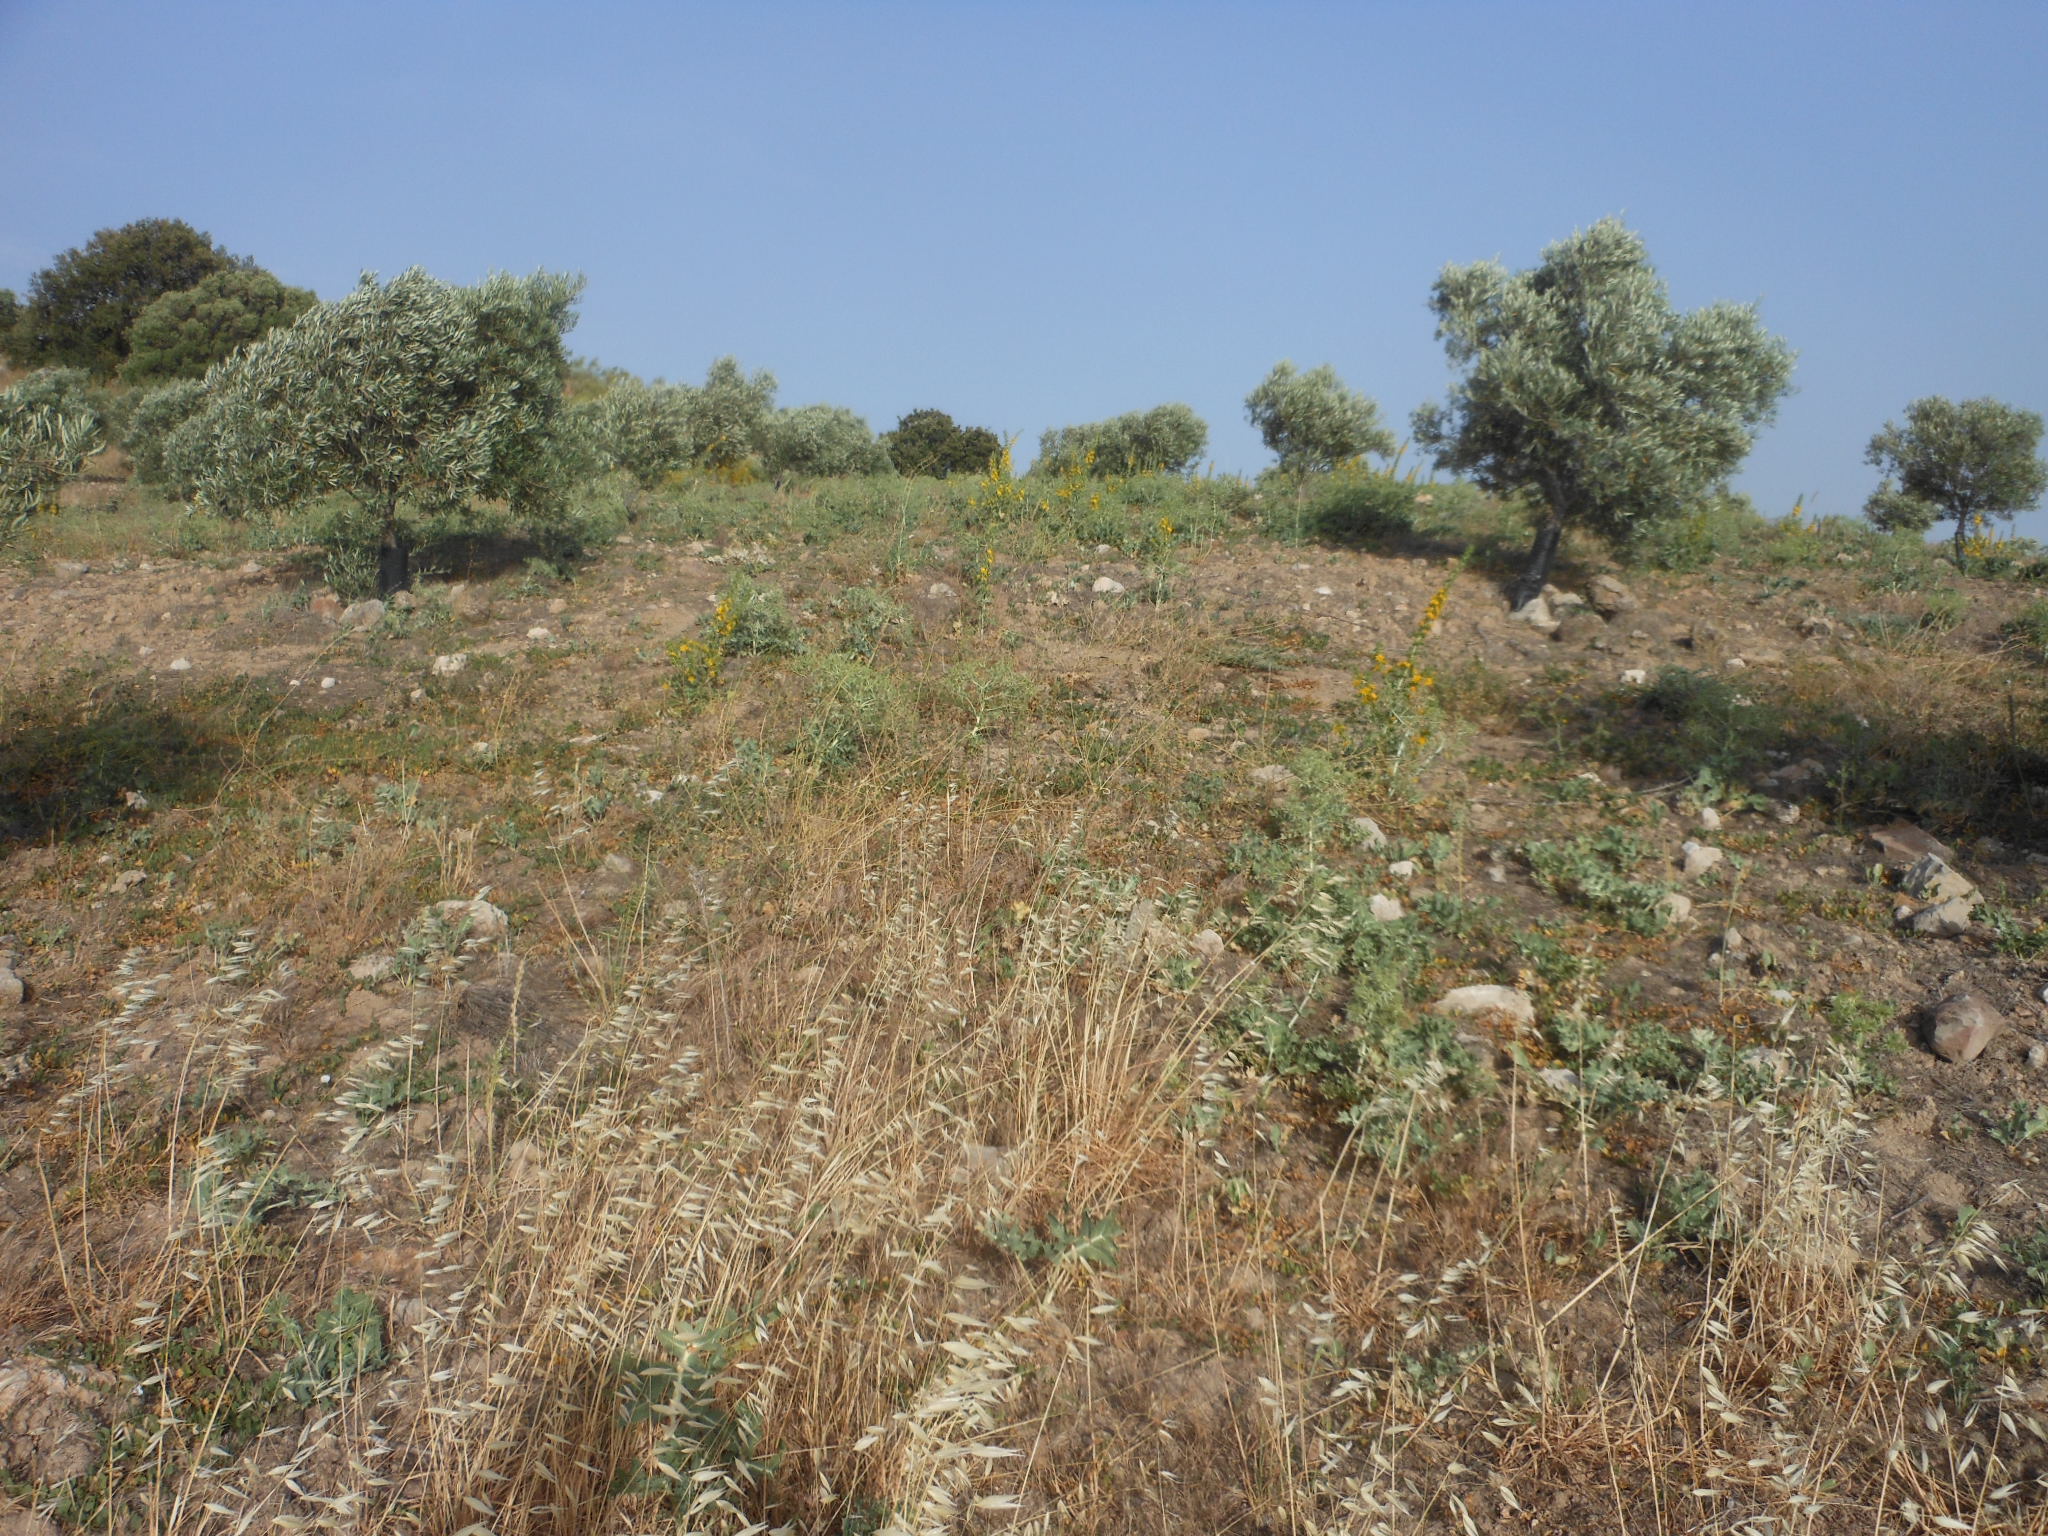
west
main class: Cropland
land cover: Olive groves
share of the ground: 10 - 25 %
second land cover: Spontaneously vegetated surfaces
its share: 50 - 75 %
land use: Agriculture (excluding fallow land and kitchen gardens)
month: June
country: ES
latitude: 37.1342
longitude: -5.0326
